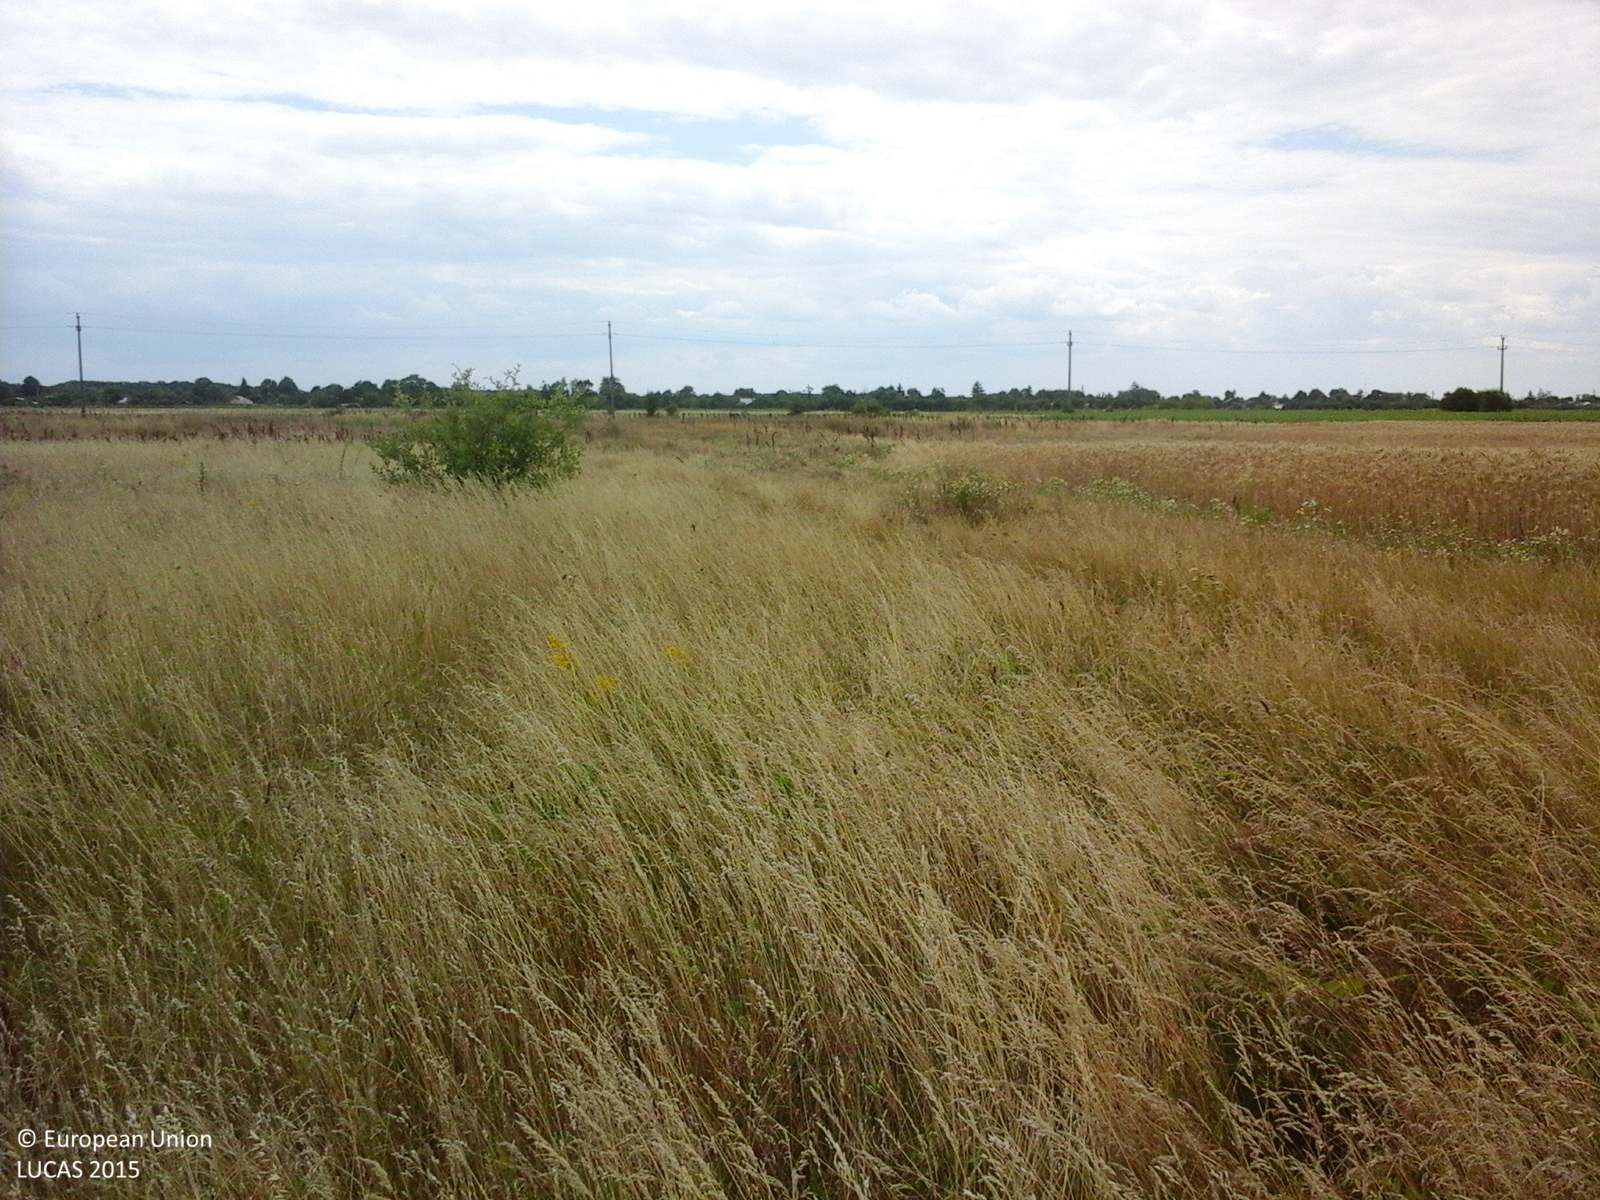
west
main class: Grassland
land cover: Spontaneously vegetated surfaces
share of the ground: > 75 %
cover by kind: herbaceous plants 100 %
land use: Agriculture (excluding fallow land and kitchen gardens)
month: July
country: RO
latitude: 44.3610
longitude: 25.4342
